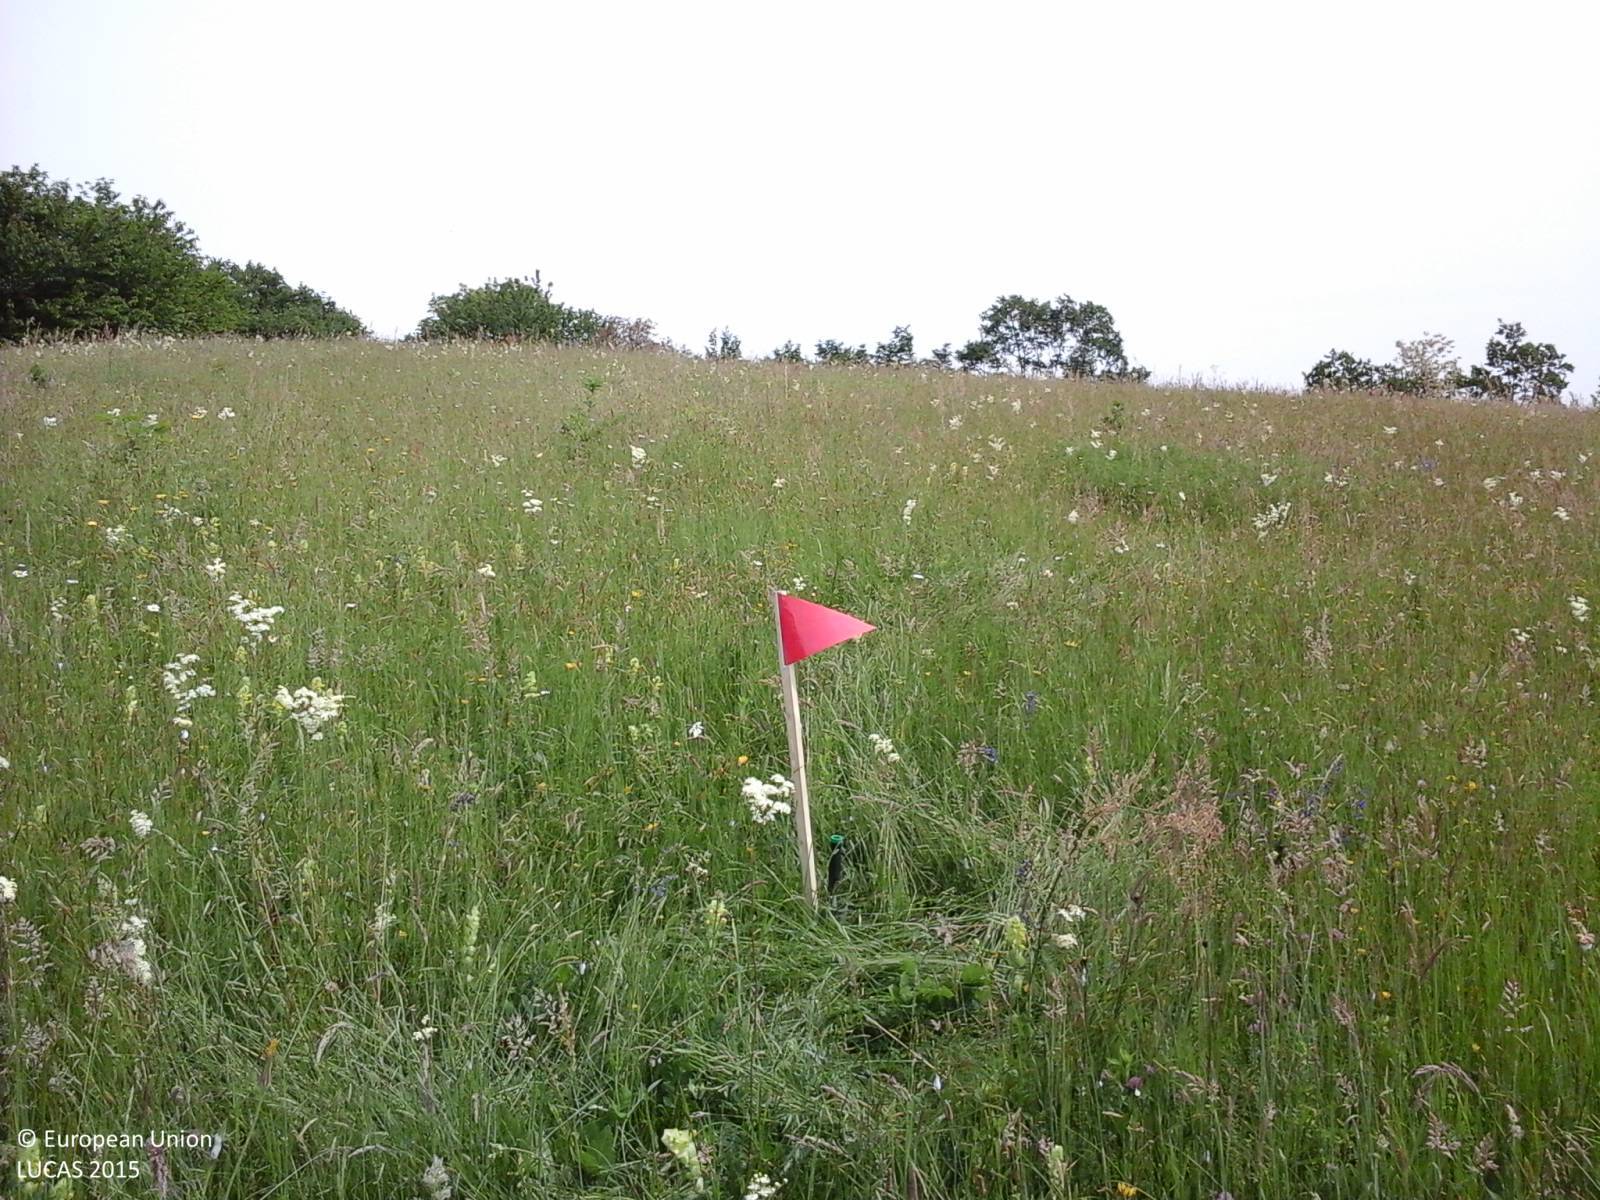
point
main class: Grassland
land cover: Grassland without tree/shrub cover
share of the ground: > 75 %
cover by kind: herbaceous plants 100 %
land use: Agriculture (excluding fallow land and kitchen gardens)
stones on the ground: < 10 %
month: May
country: IT
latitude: 46.1818
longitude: 13.0411
